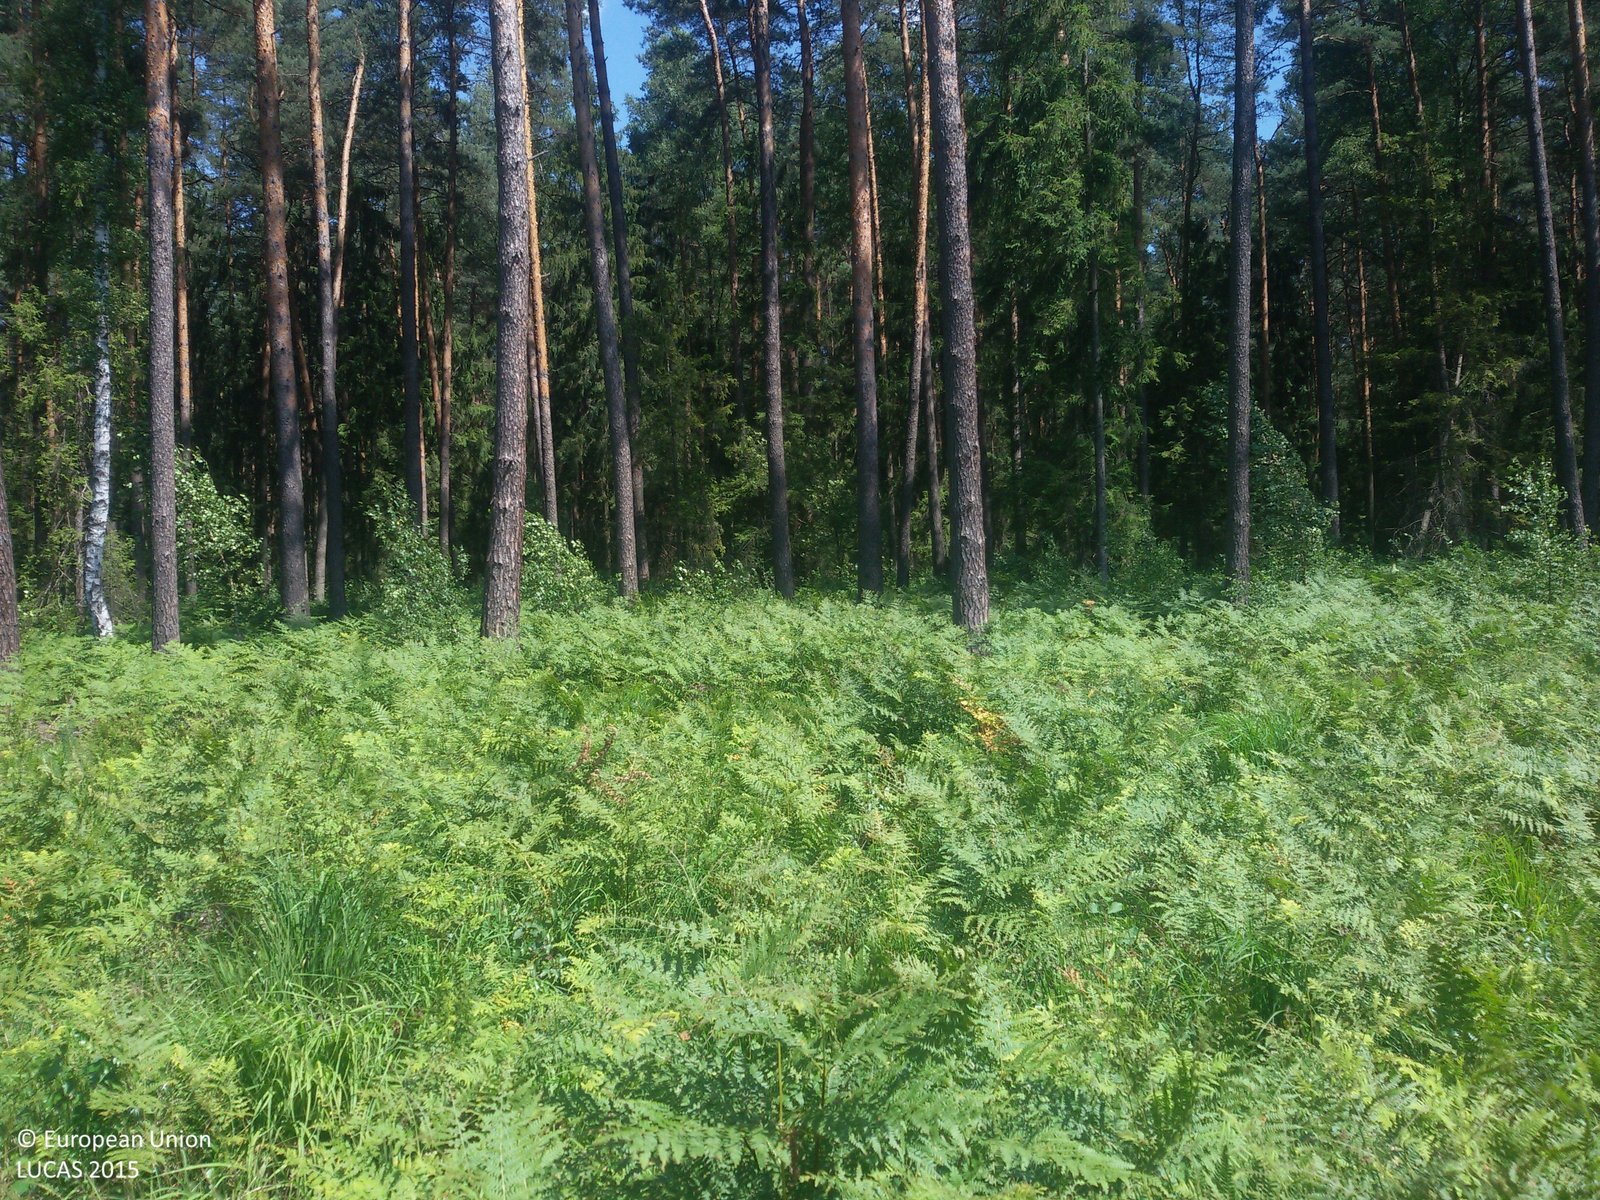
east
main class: Grassland
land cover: Spontaneously vegetated surfaces
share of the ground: > 75 %
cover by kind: herbaceous plants 100 %
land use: Forestry
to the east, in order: Spontaneously vegetated surfaces; Pine dominated coniferous woodland; Tracks; Pine dominated mixed woodland
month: July
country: PL
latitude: 50.5592
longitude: 17.6503
